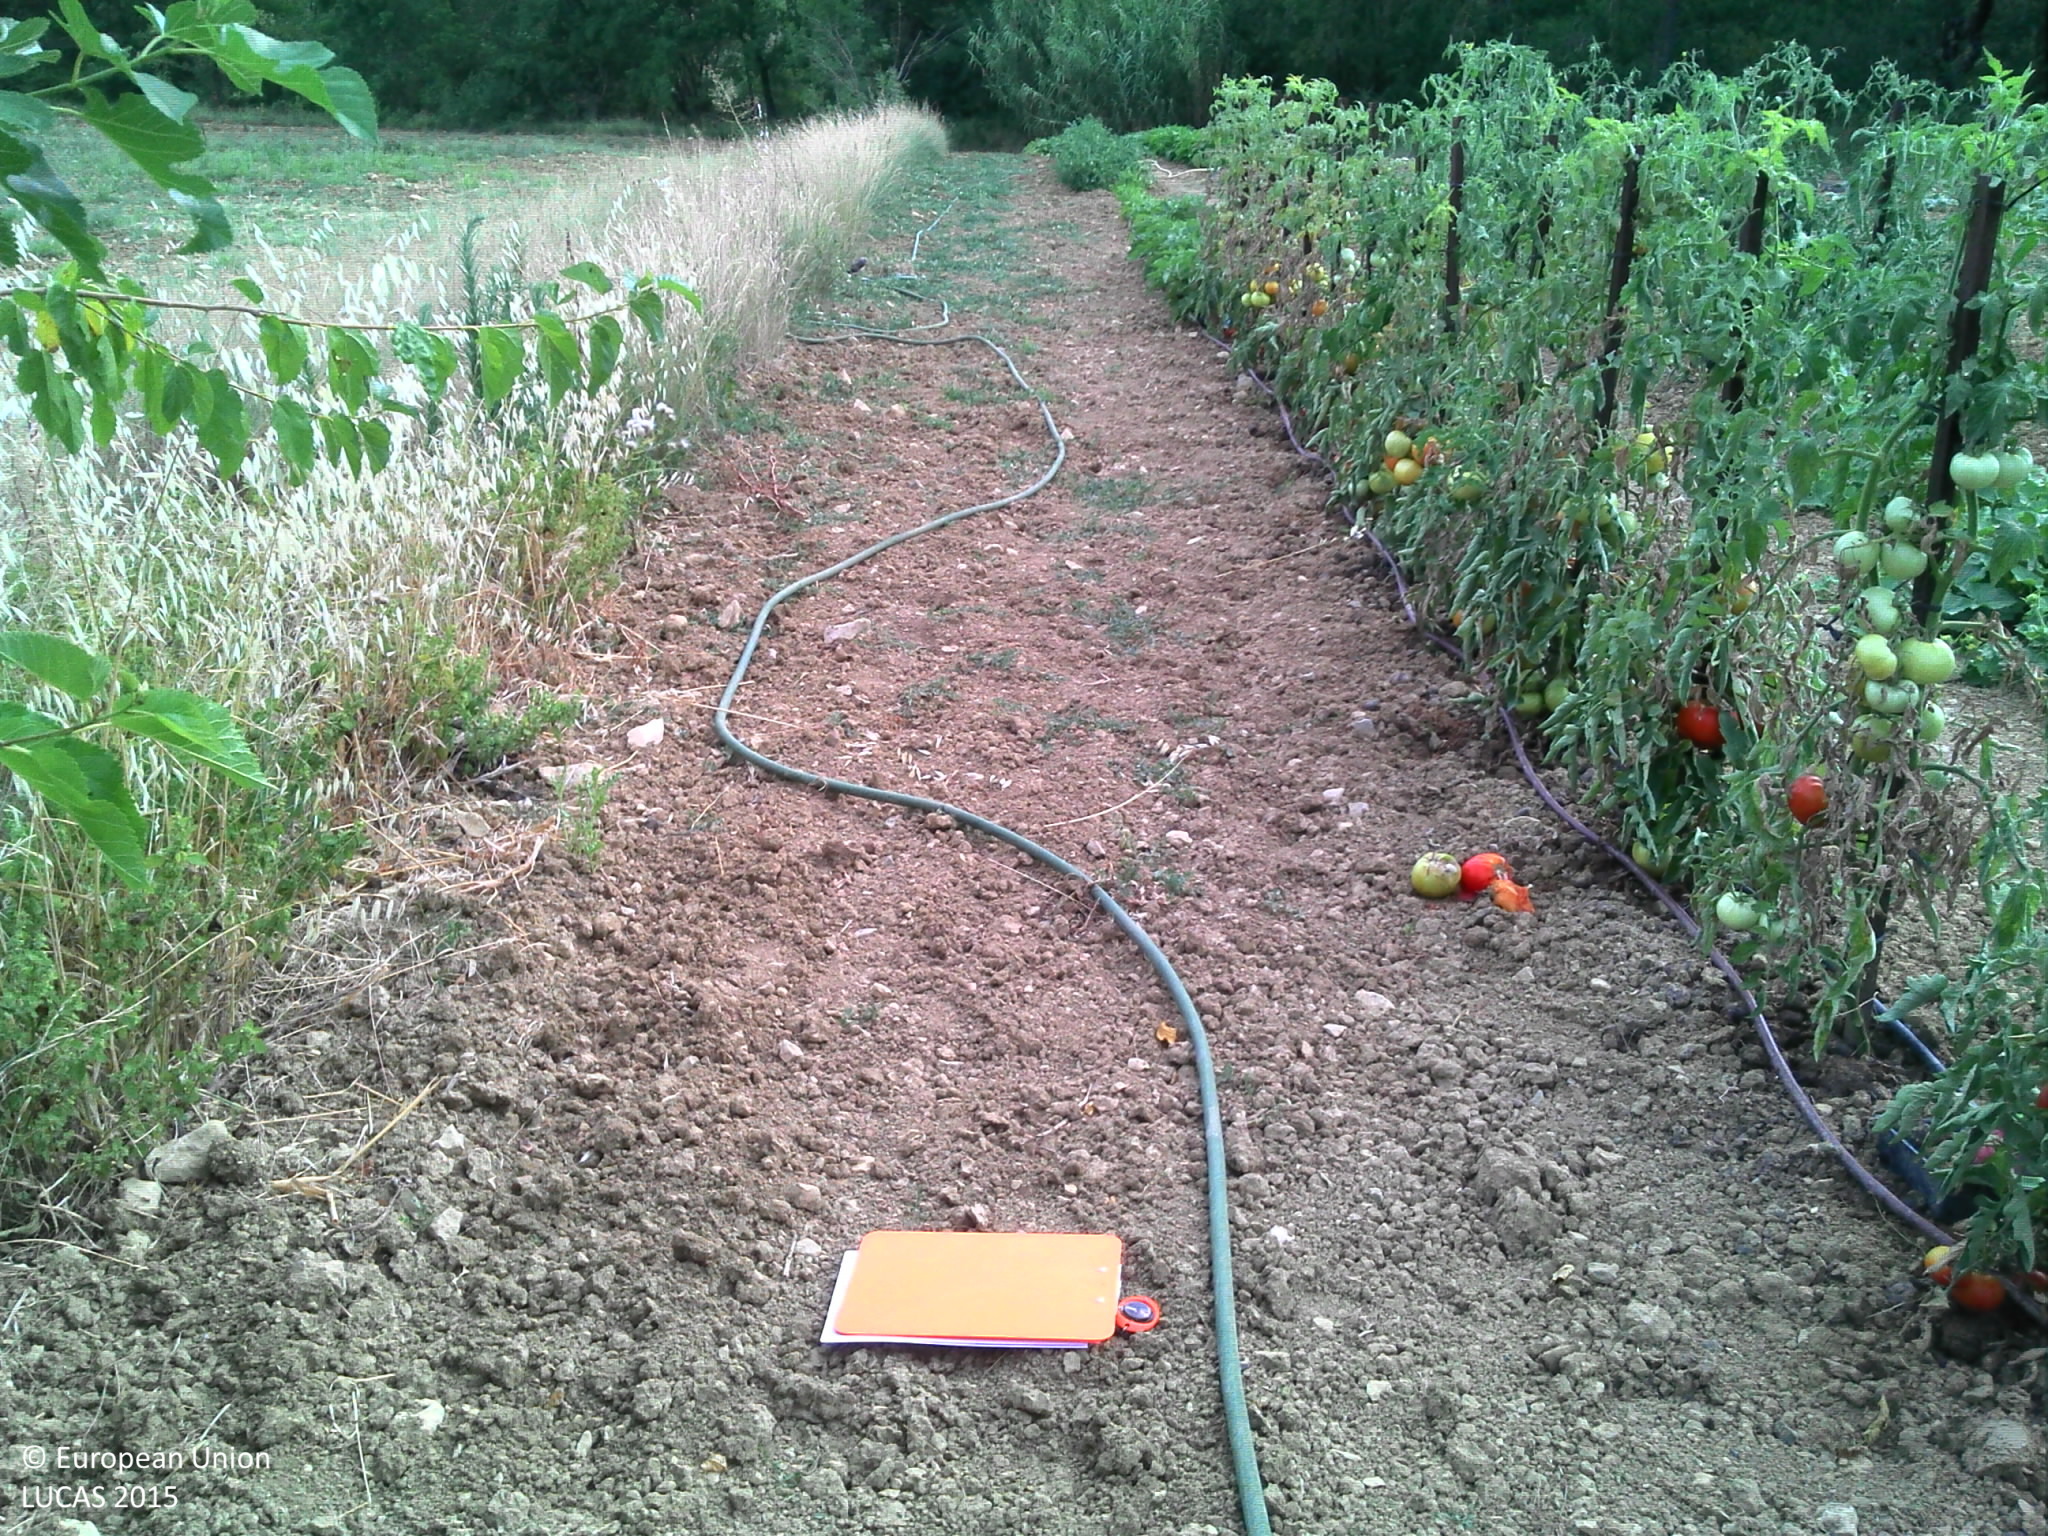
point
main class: Cropland
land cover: Tomatoes
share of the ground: 10 - 25 %
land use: Agriculture (excluding fallow land and kitchen gardens)
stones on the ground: 25 - 50 %
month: July
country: FR
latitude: 44.3399
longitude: 4.3252
